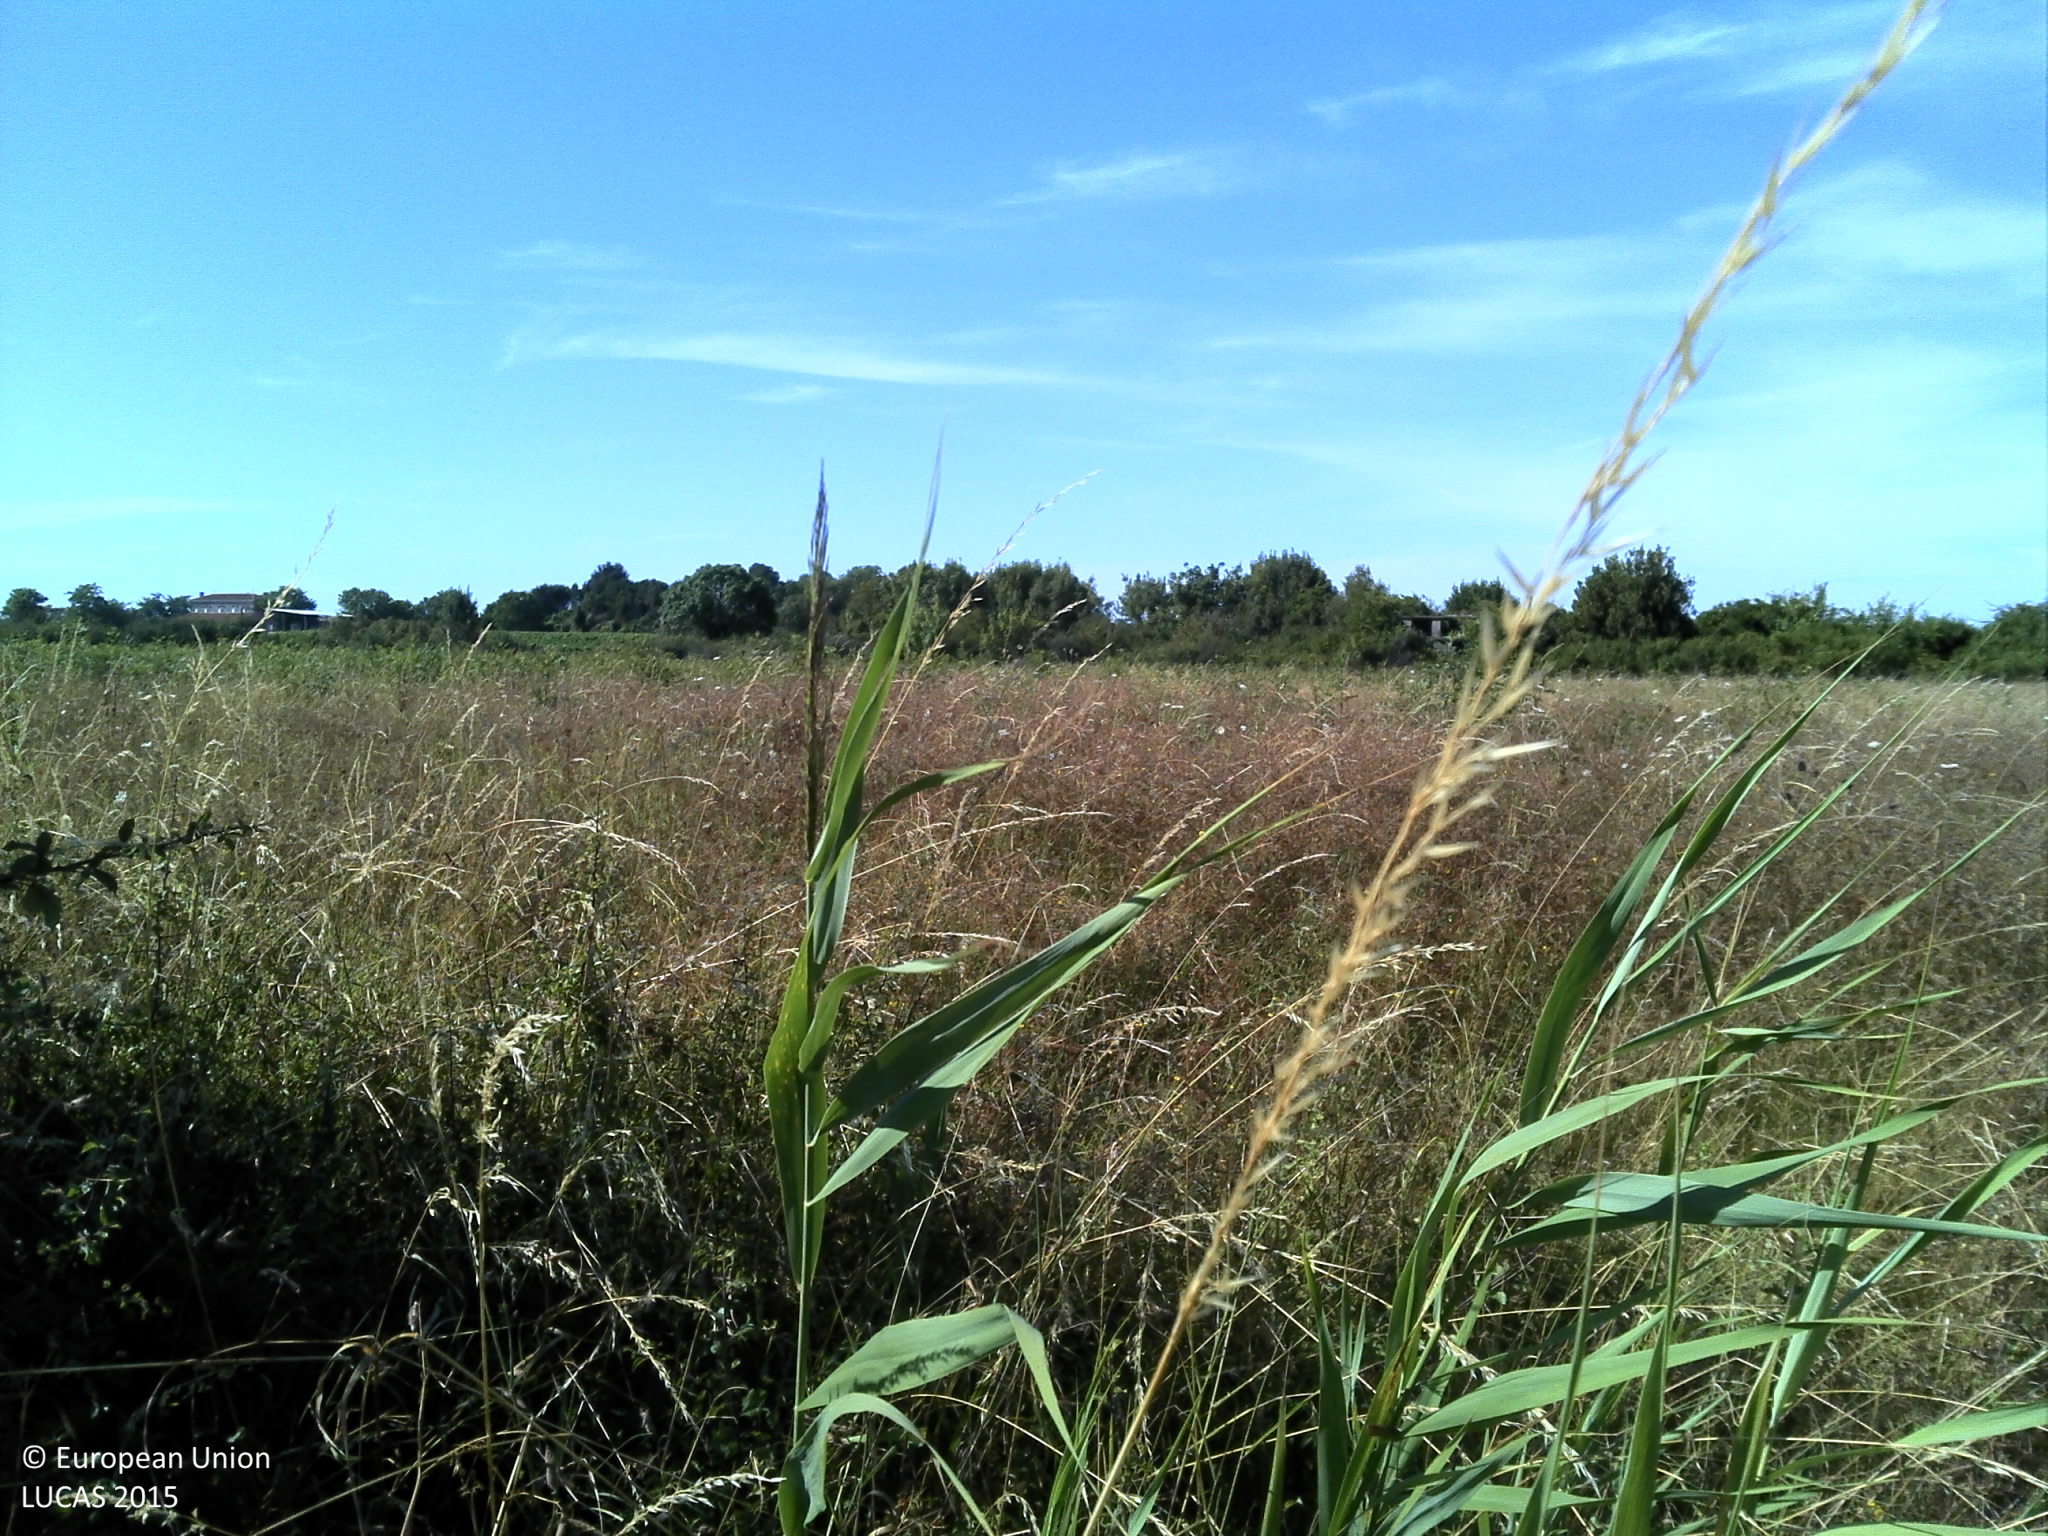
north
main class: Grassland
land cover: Grassland without tree/shrub cover
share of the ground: > 75 %
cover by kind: herbaceous plants 100 %
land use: Agriculture (excluding fallow land and kitchen gardens)
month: July
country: FR
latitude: 45.3476
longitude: -0.8087
